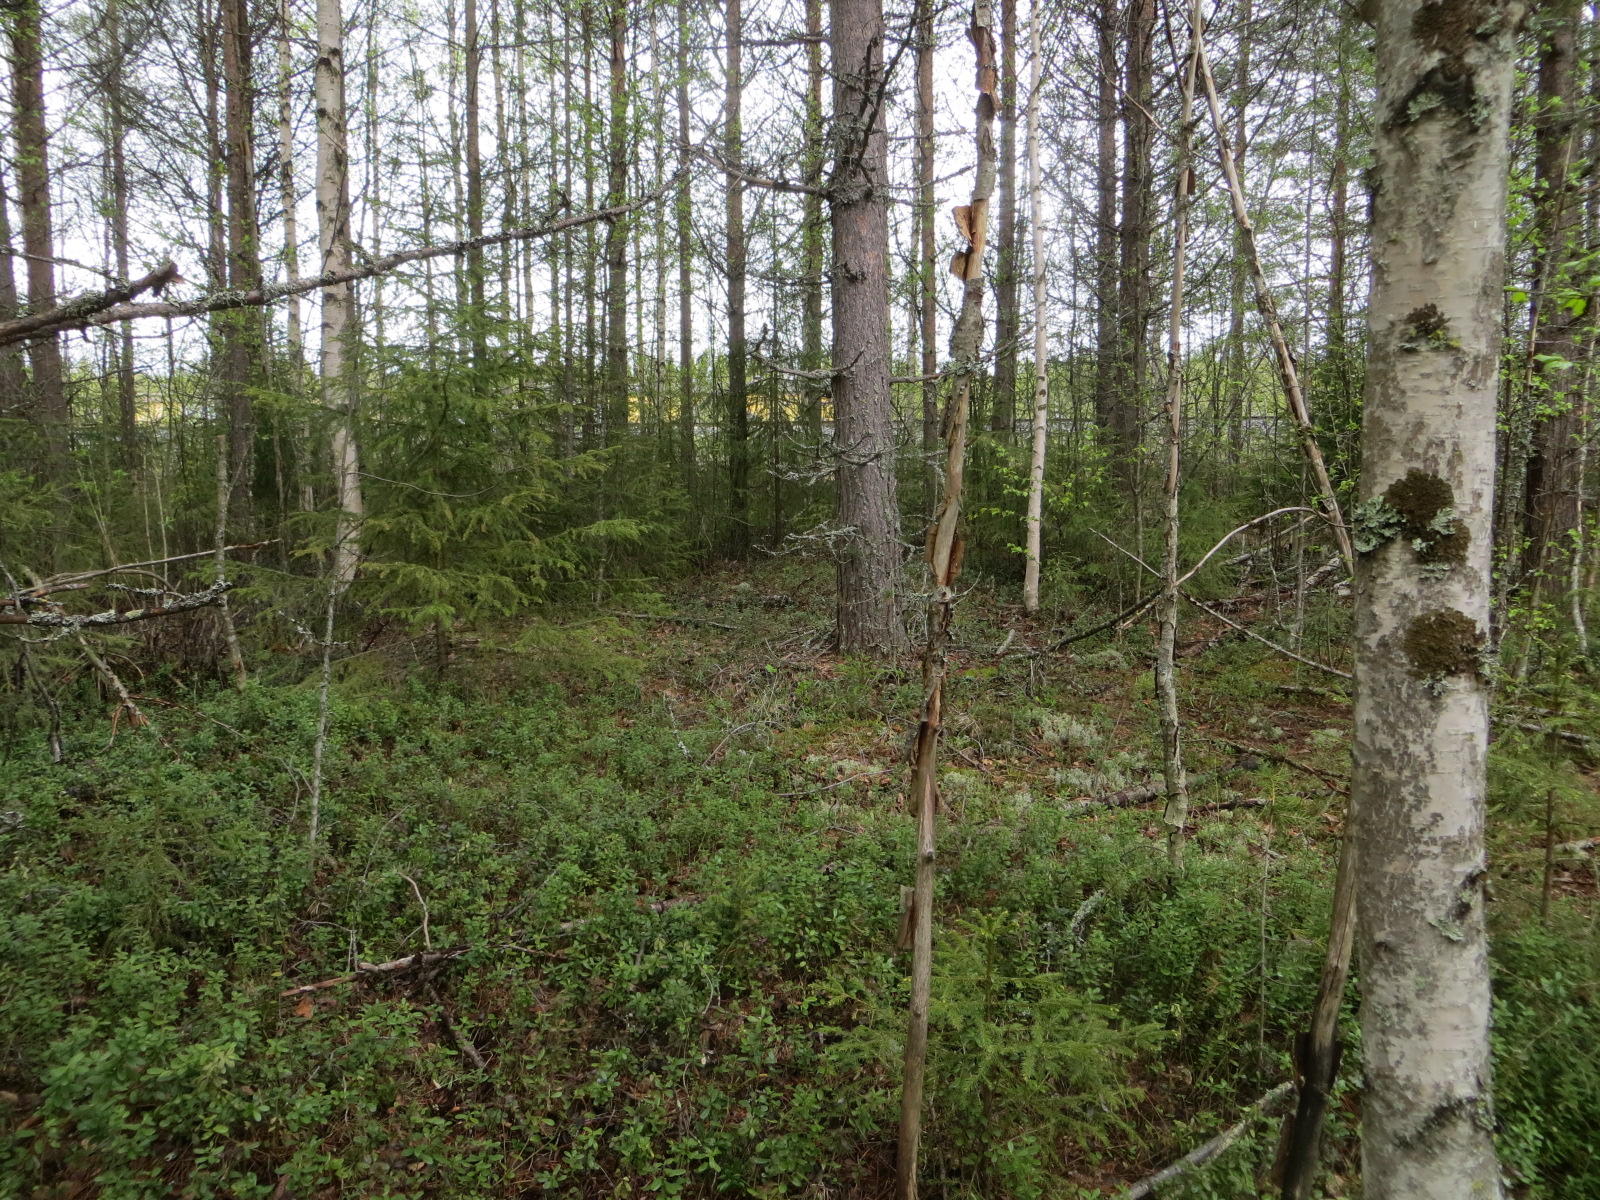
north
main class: Woodland
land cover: Other mixed woodland
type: boreal forest
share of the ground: > 75 %
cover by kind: coniferous forest trees 45 %, broadleaved forest trees 45 %, shrubs 10 %
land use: Forestry
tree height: > 5 m
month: June
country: FI
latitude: 66.5231
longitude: 25.8398
